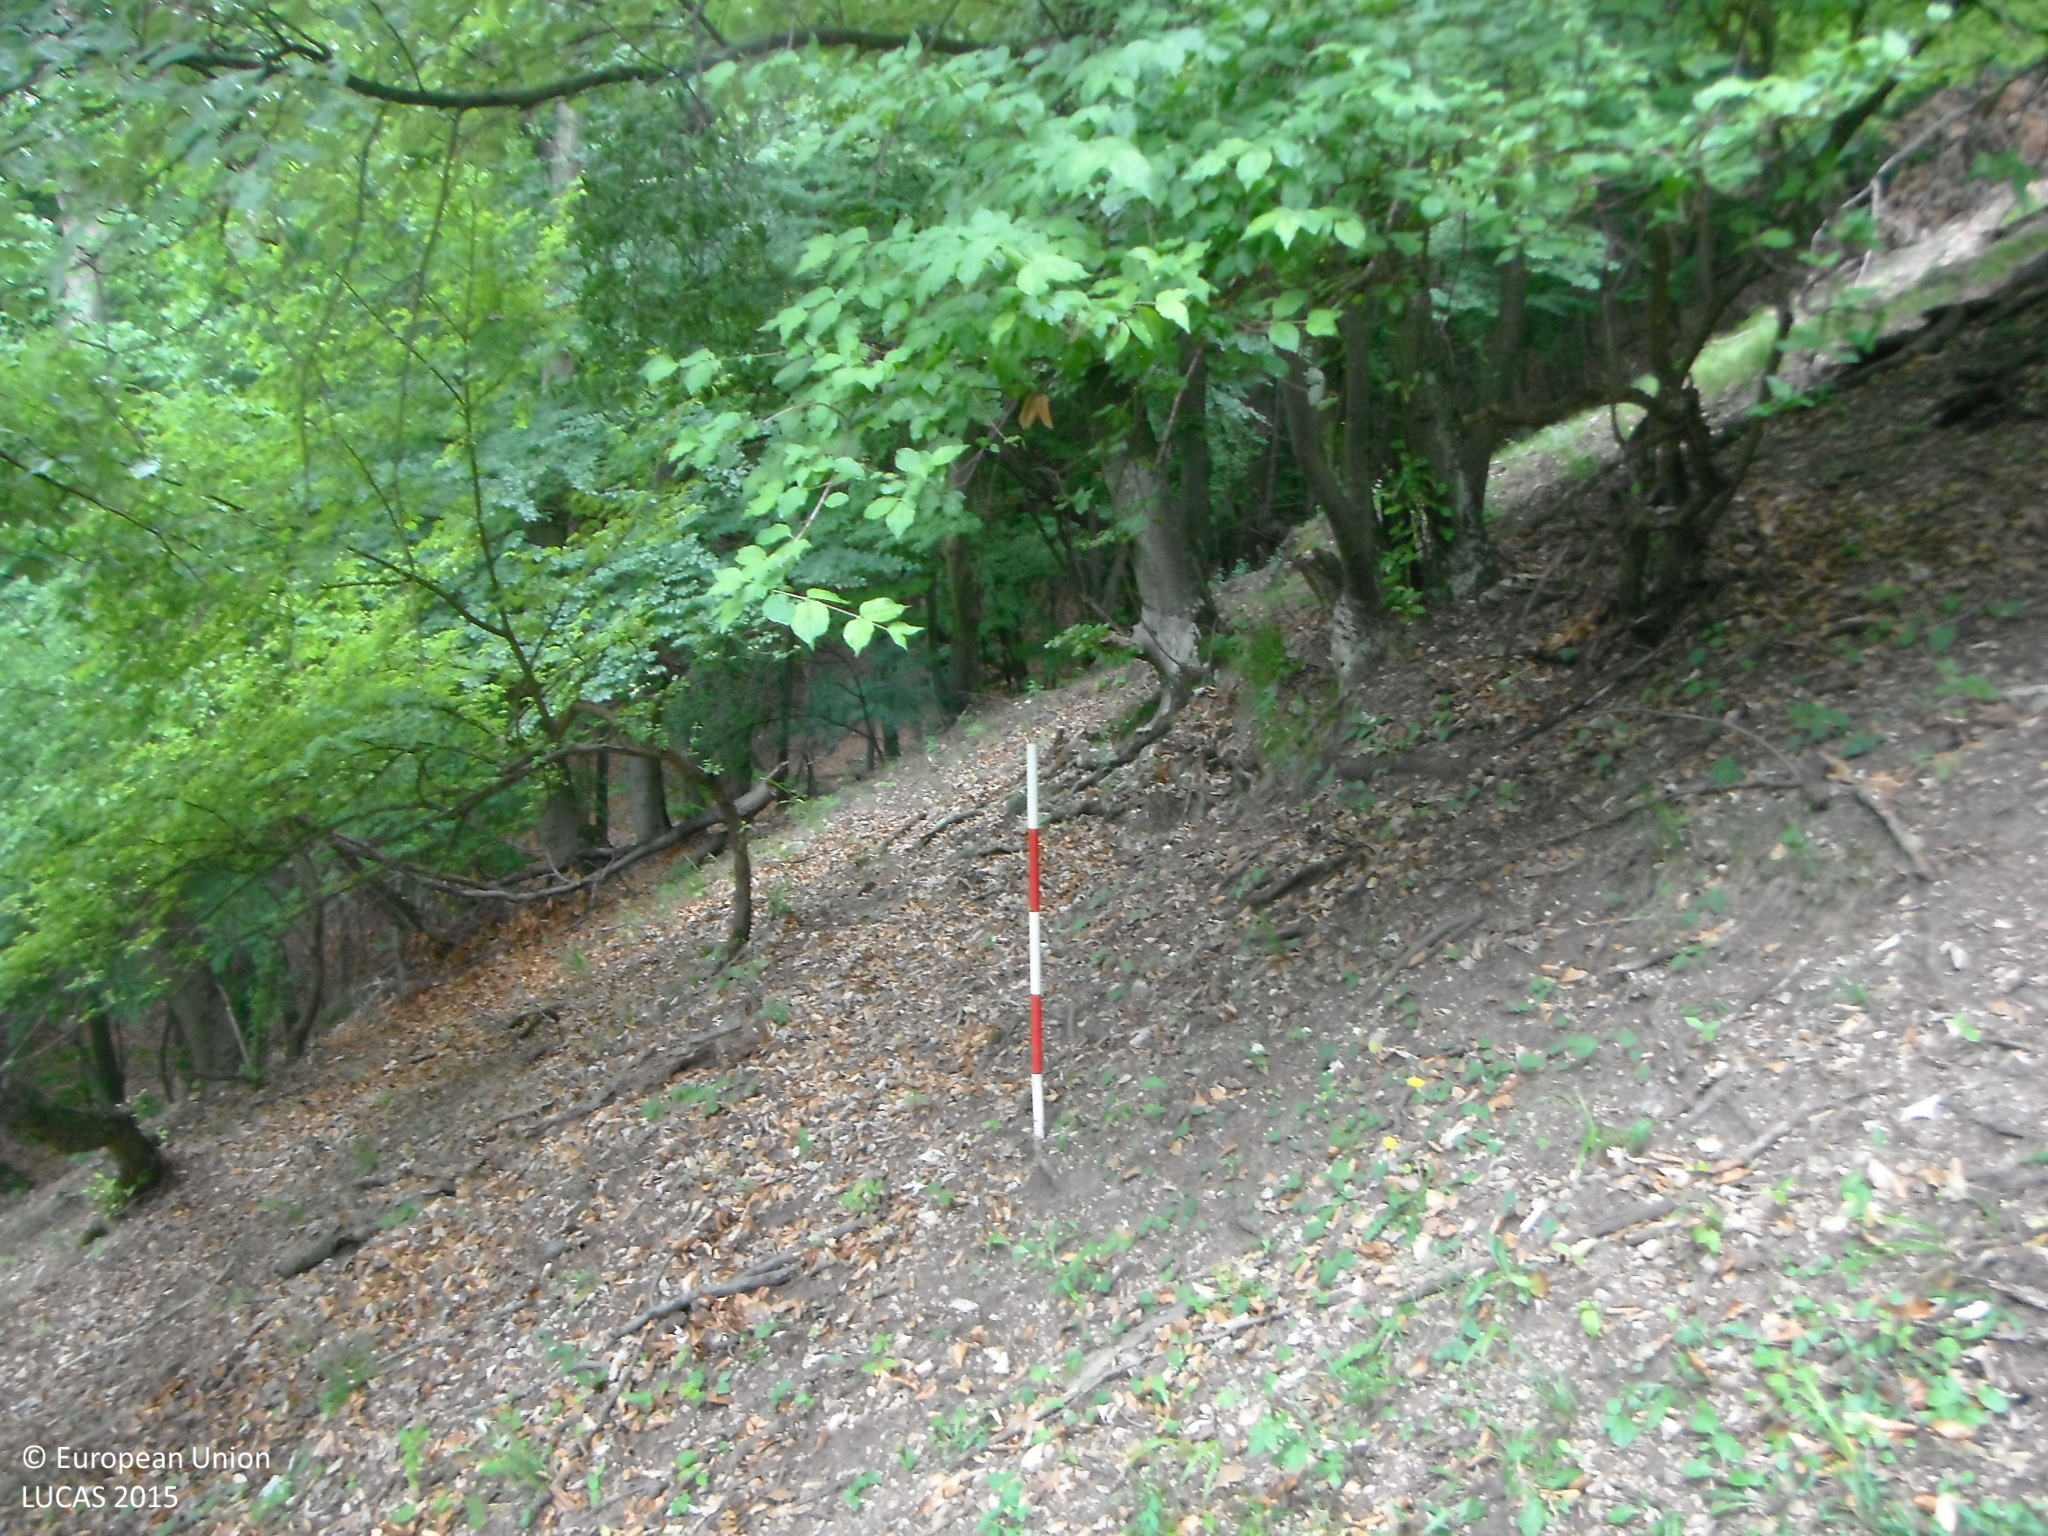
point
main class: Woodland
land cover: Broadleaved woodland
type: beech forest
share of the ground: > 75 %
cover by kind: broadleaved forest trees 80 %, herbaceous plants 15 %, shrubs 5 %
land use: Forestry
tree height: > 5 m
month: June
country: SK
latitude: 48.7541
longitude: 18.3817
